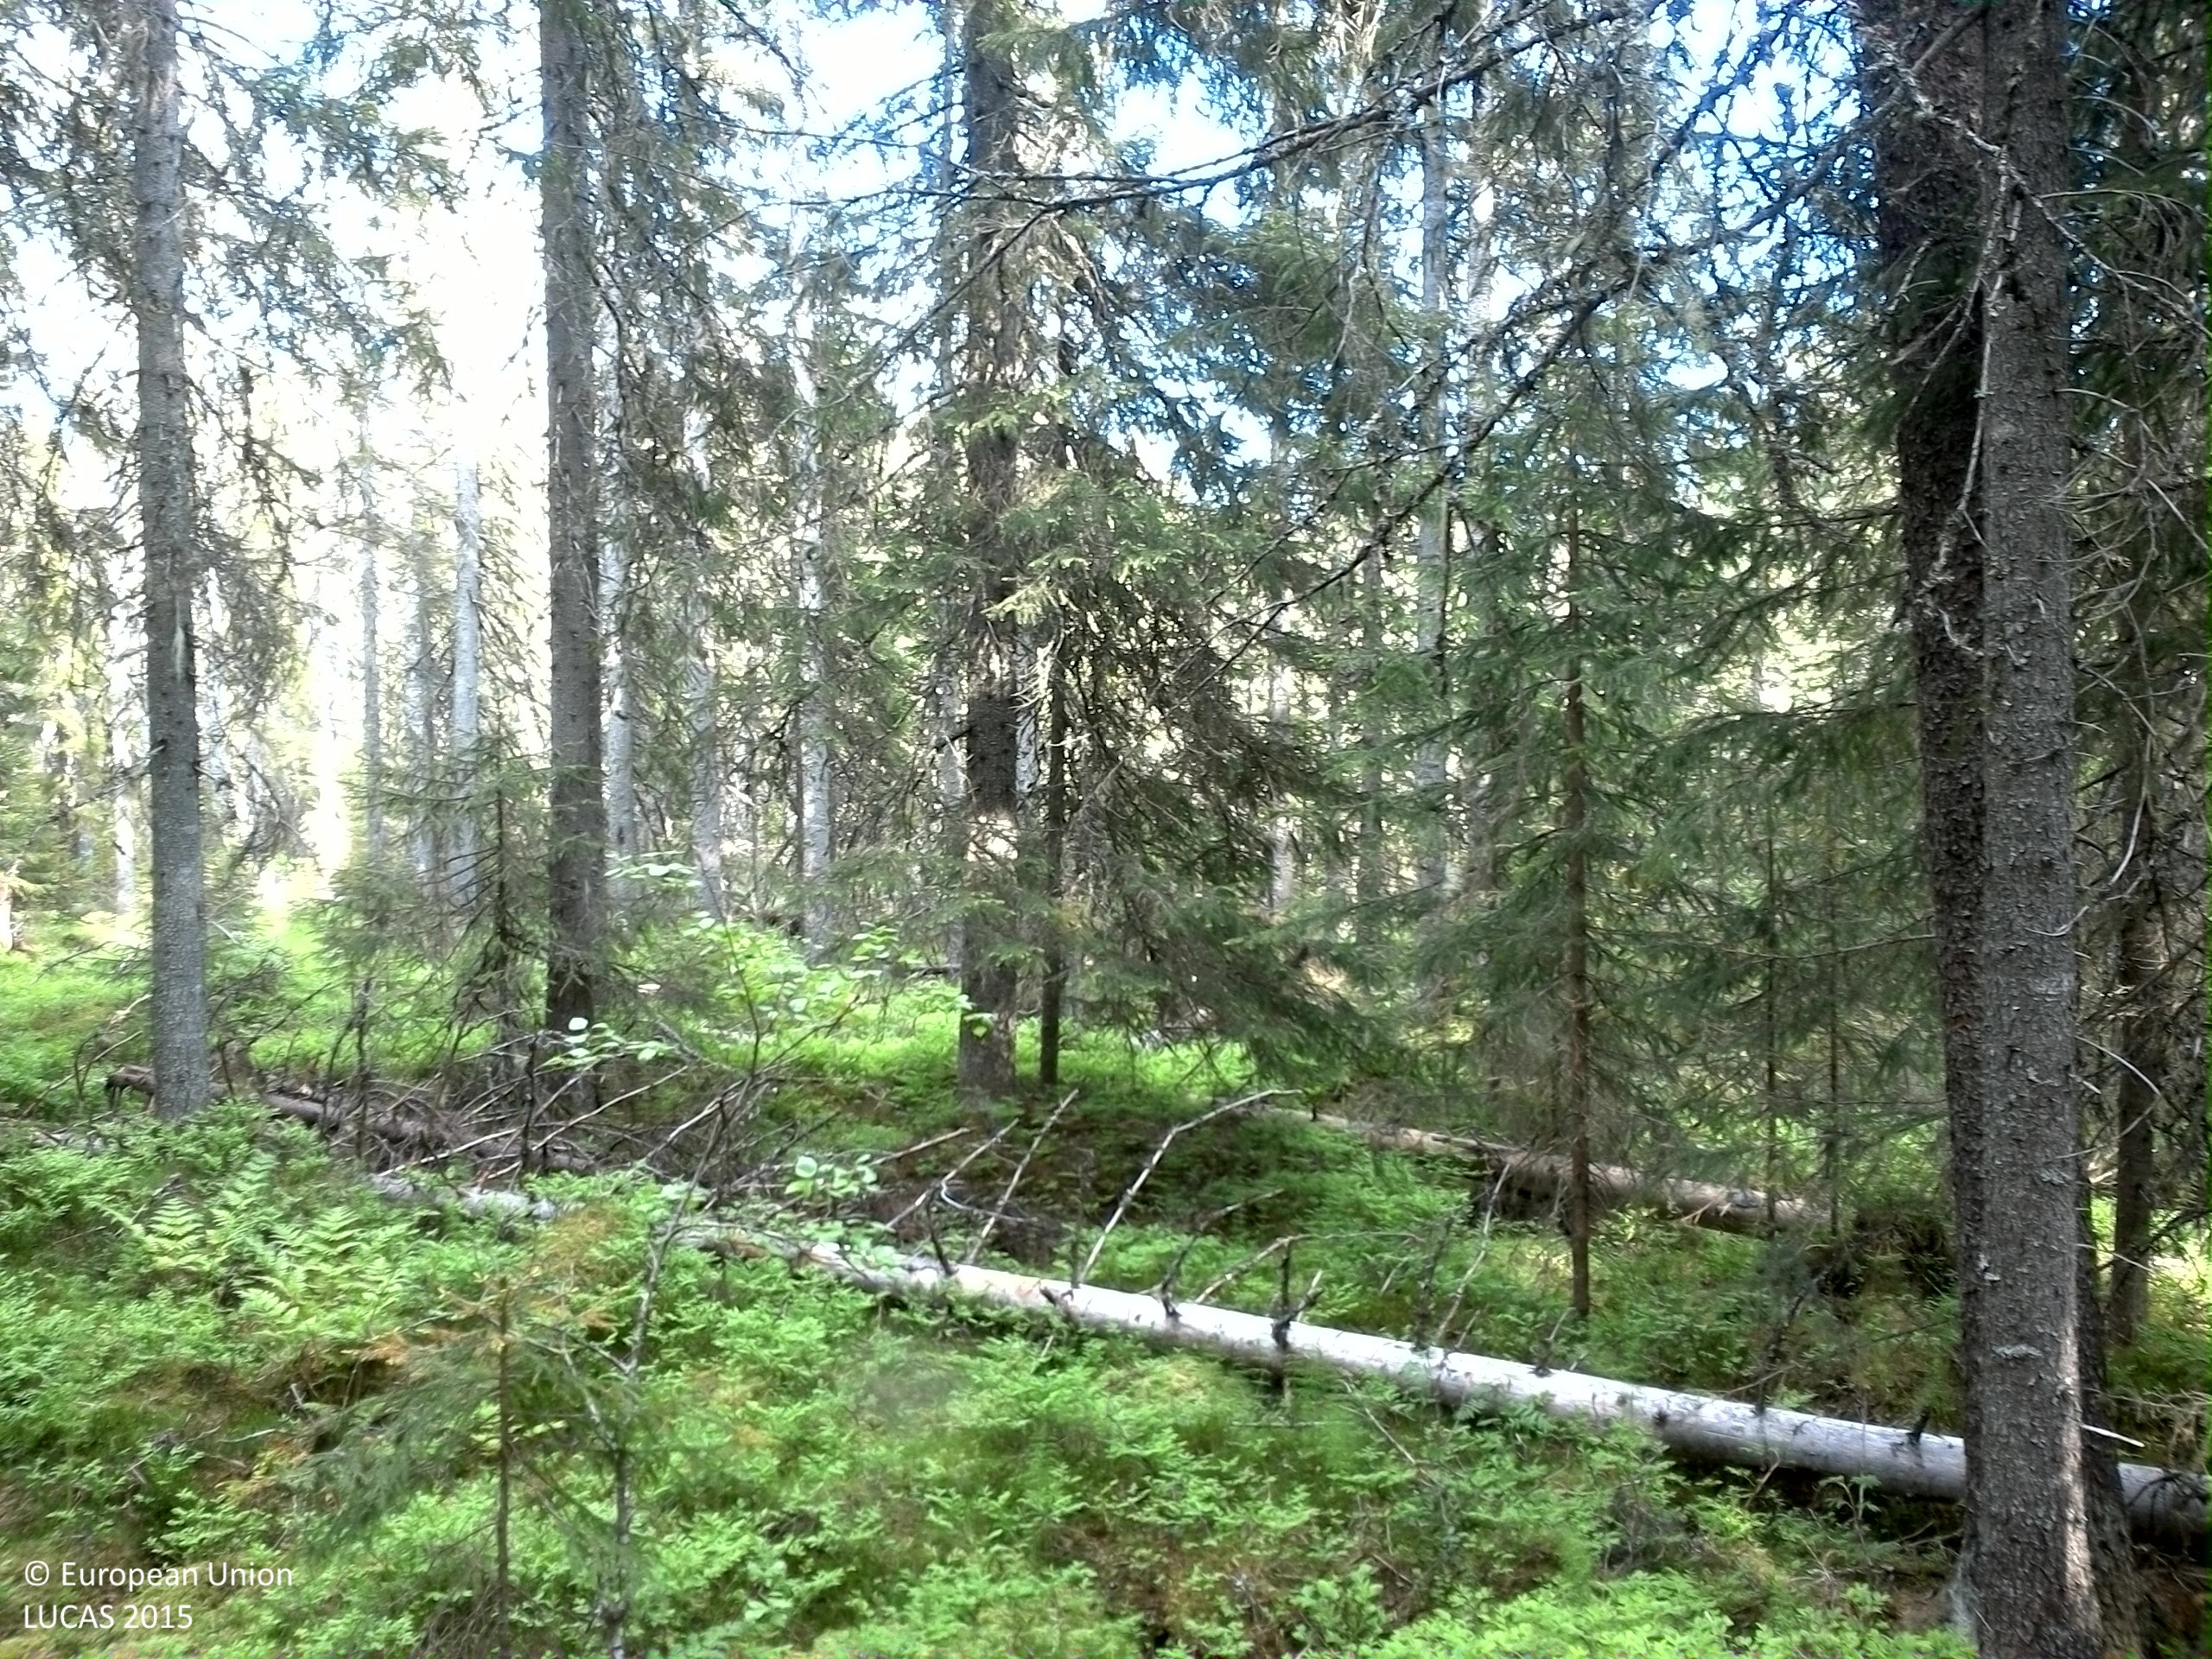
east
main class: Woodland
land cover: Spruce dominated coniferous woodland
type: boreal forest
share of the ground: 50 - 75 %
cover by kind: coniferous forest trees 60 %, shrubs 30 %, broadleaved forest trees 10 %
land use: Forestry
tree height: > 5 m
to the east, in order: Spruce dominated coniferous woodland; Pine dominated mixed woodland; Ditches and canals; Spruce dominated coniferous woodland
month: June
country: SE
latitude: 63.3910
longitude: 18.1205
